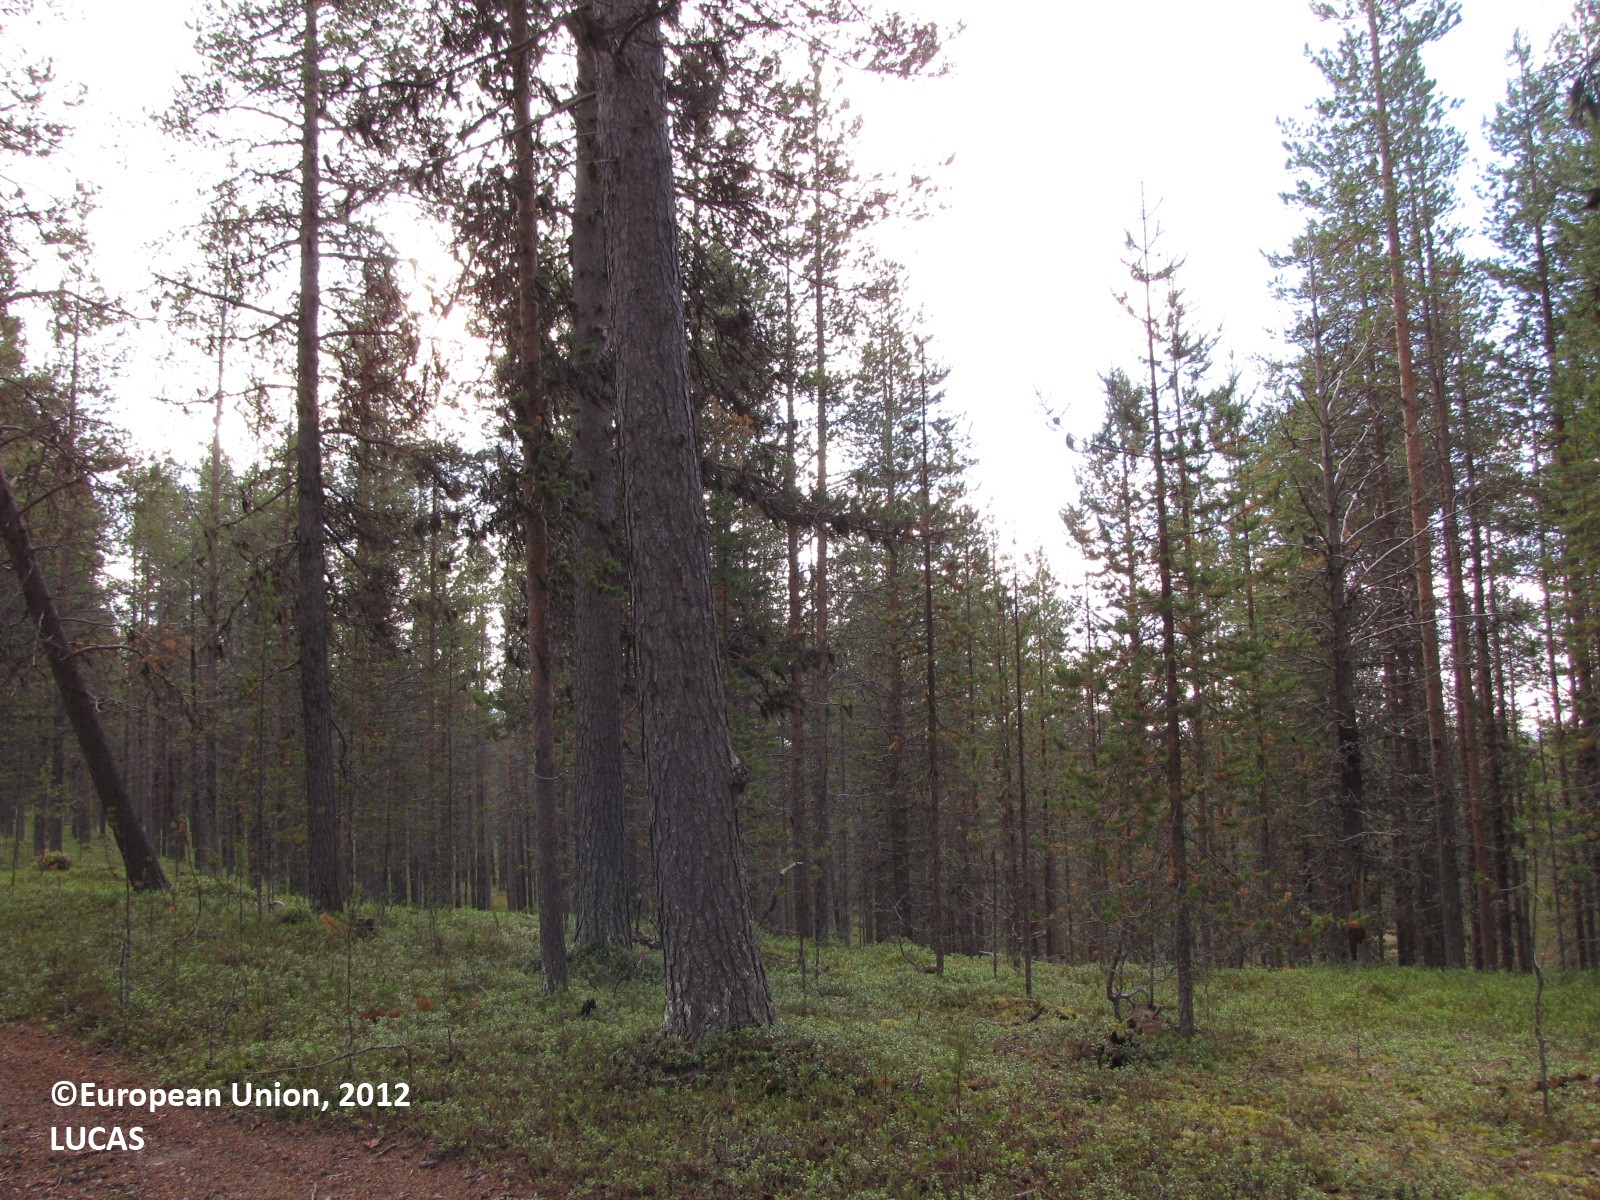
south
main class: Woodland
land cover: Pine dominated coniferous woodland
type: boreal forest
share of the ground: 25 - 50 %
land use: Forestry
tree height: > 5 m
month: September
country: FI
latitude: 67.8669
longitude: 23.5448
